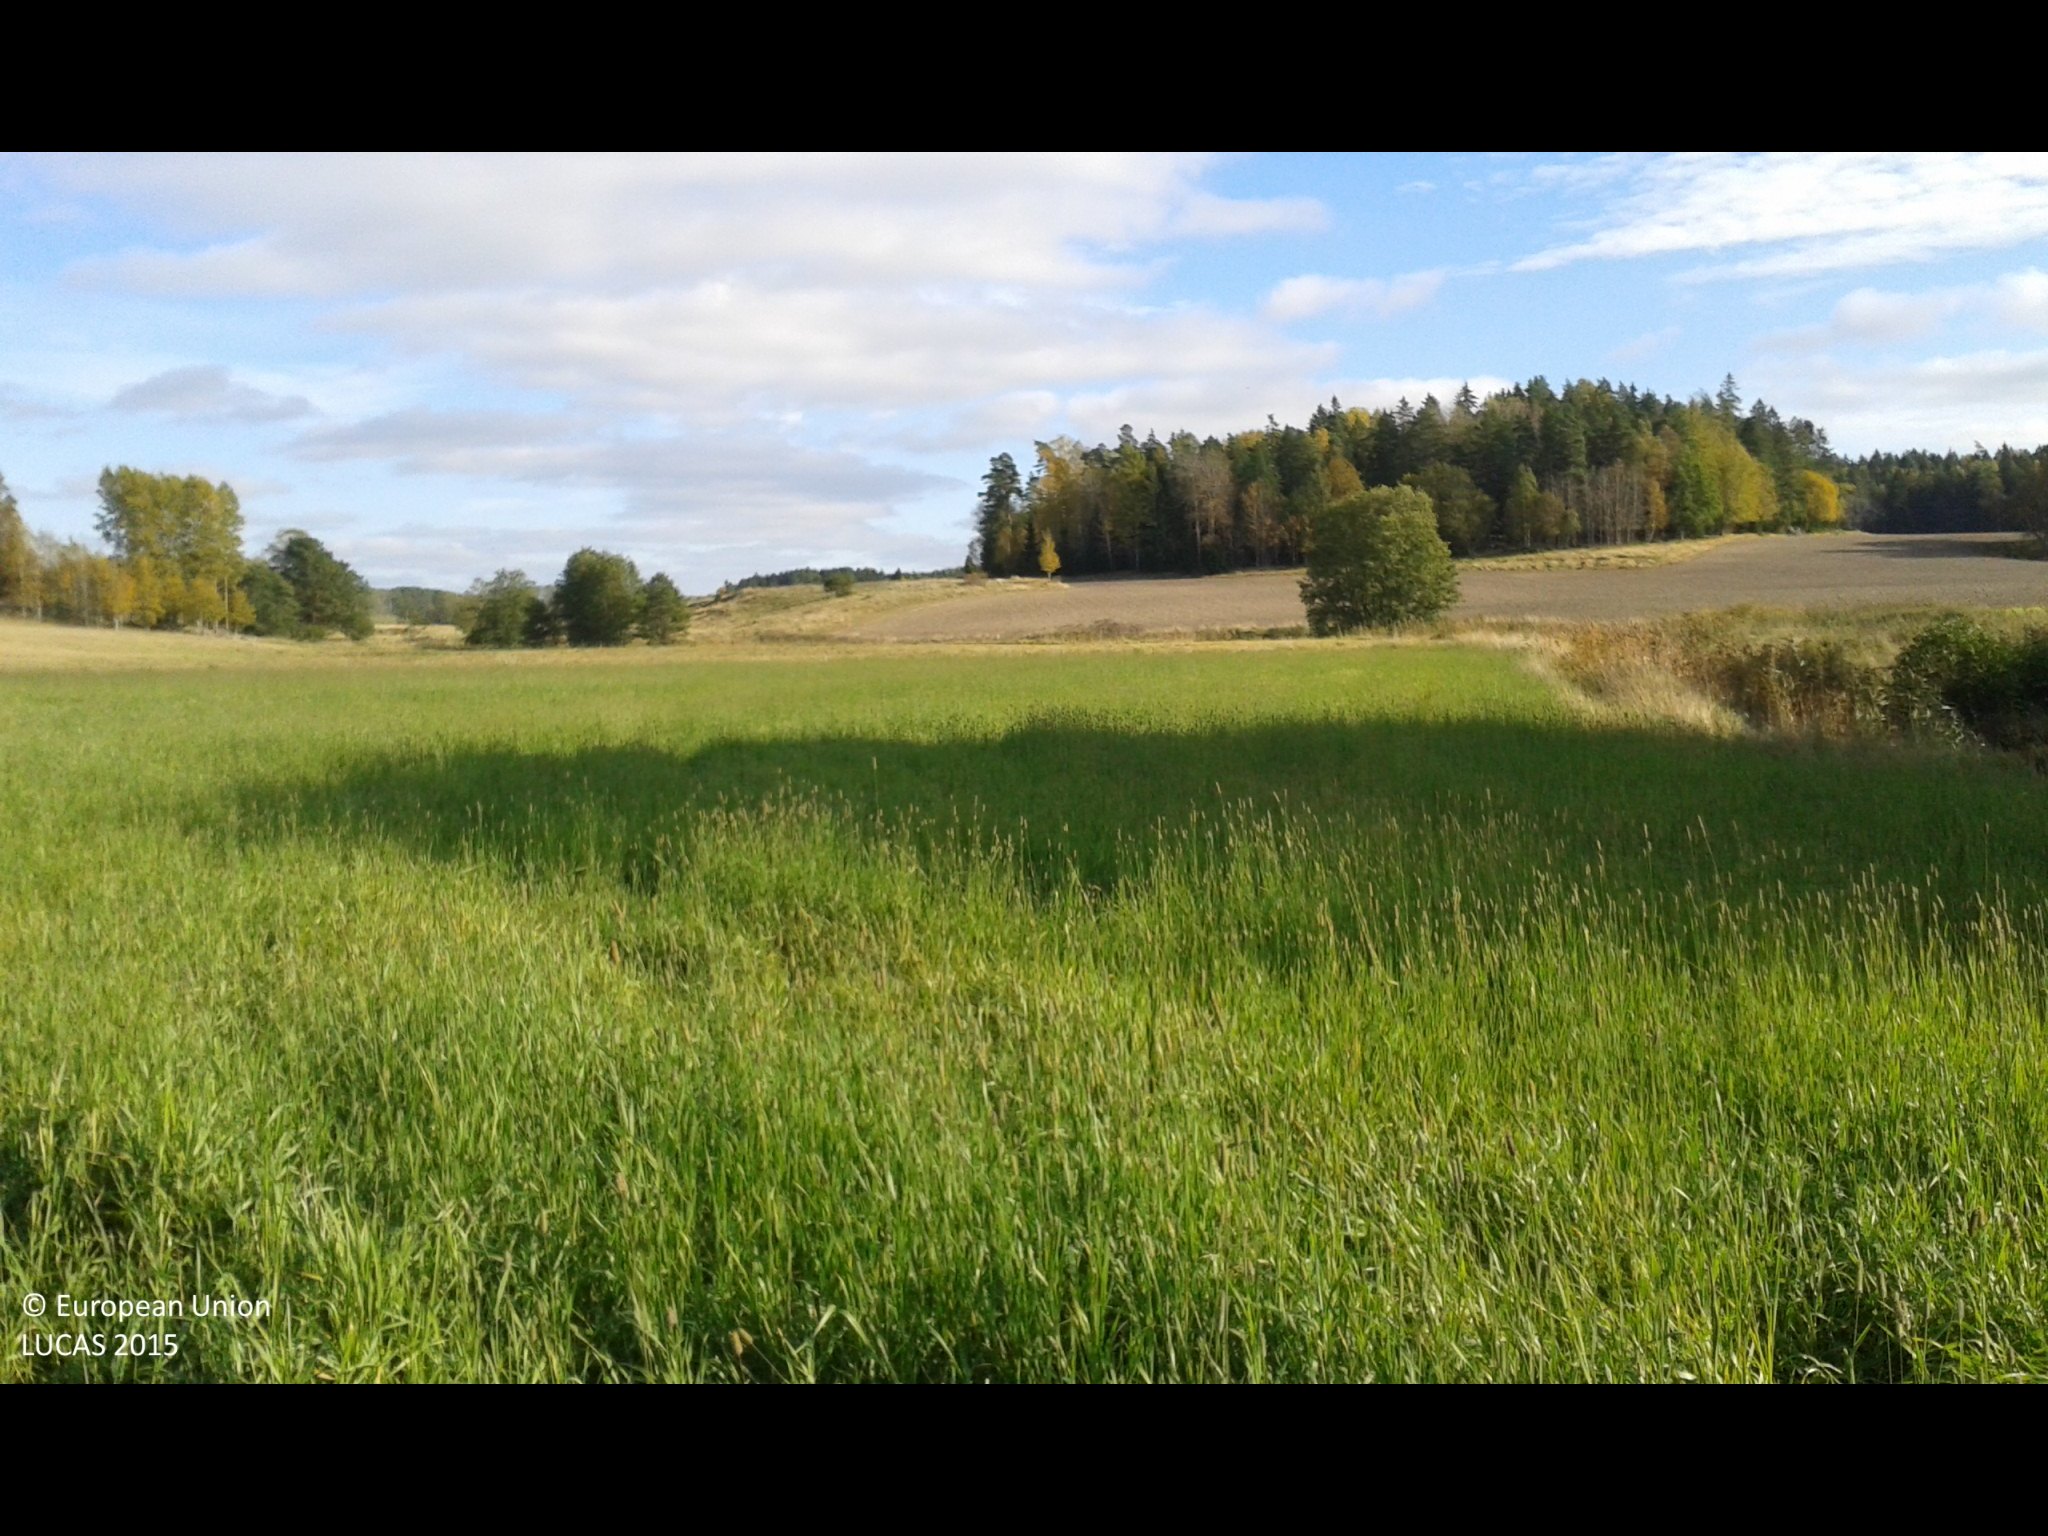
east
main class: Grassland
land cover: Grassland without tree/shrub cover
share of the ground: > 75 %
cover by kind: herbaceous plants 100 %
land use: Agriculture (excluding fallow land and kitchen gardens)
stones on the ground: < 10 %
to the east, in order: Grassland without tree/shrub cover; Ditches and canals; Grass margins; Common wheat; Grass margins; Shruby margins; Rivers and streams; Shruby margins; Grass margins; Other bare soil
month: October
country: SE
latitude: 58.9190
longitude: 17.0645
